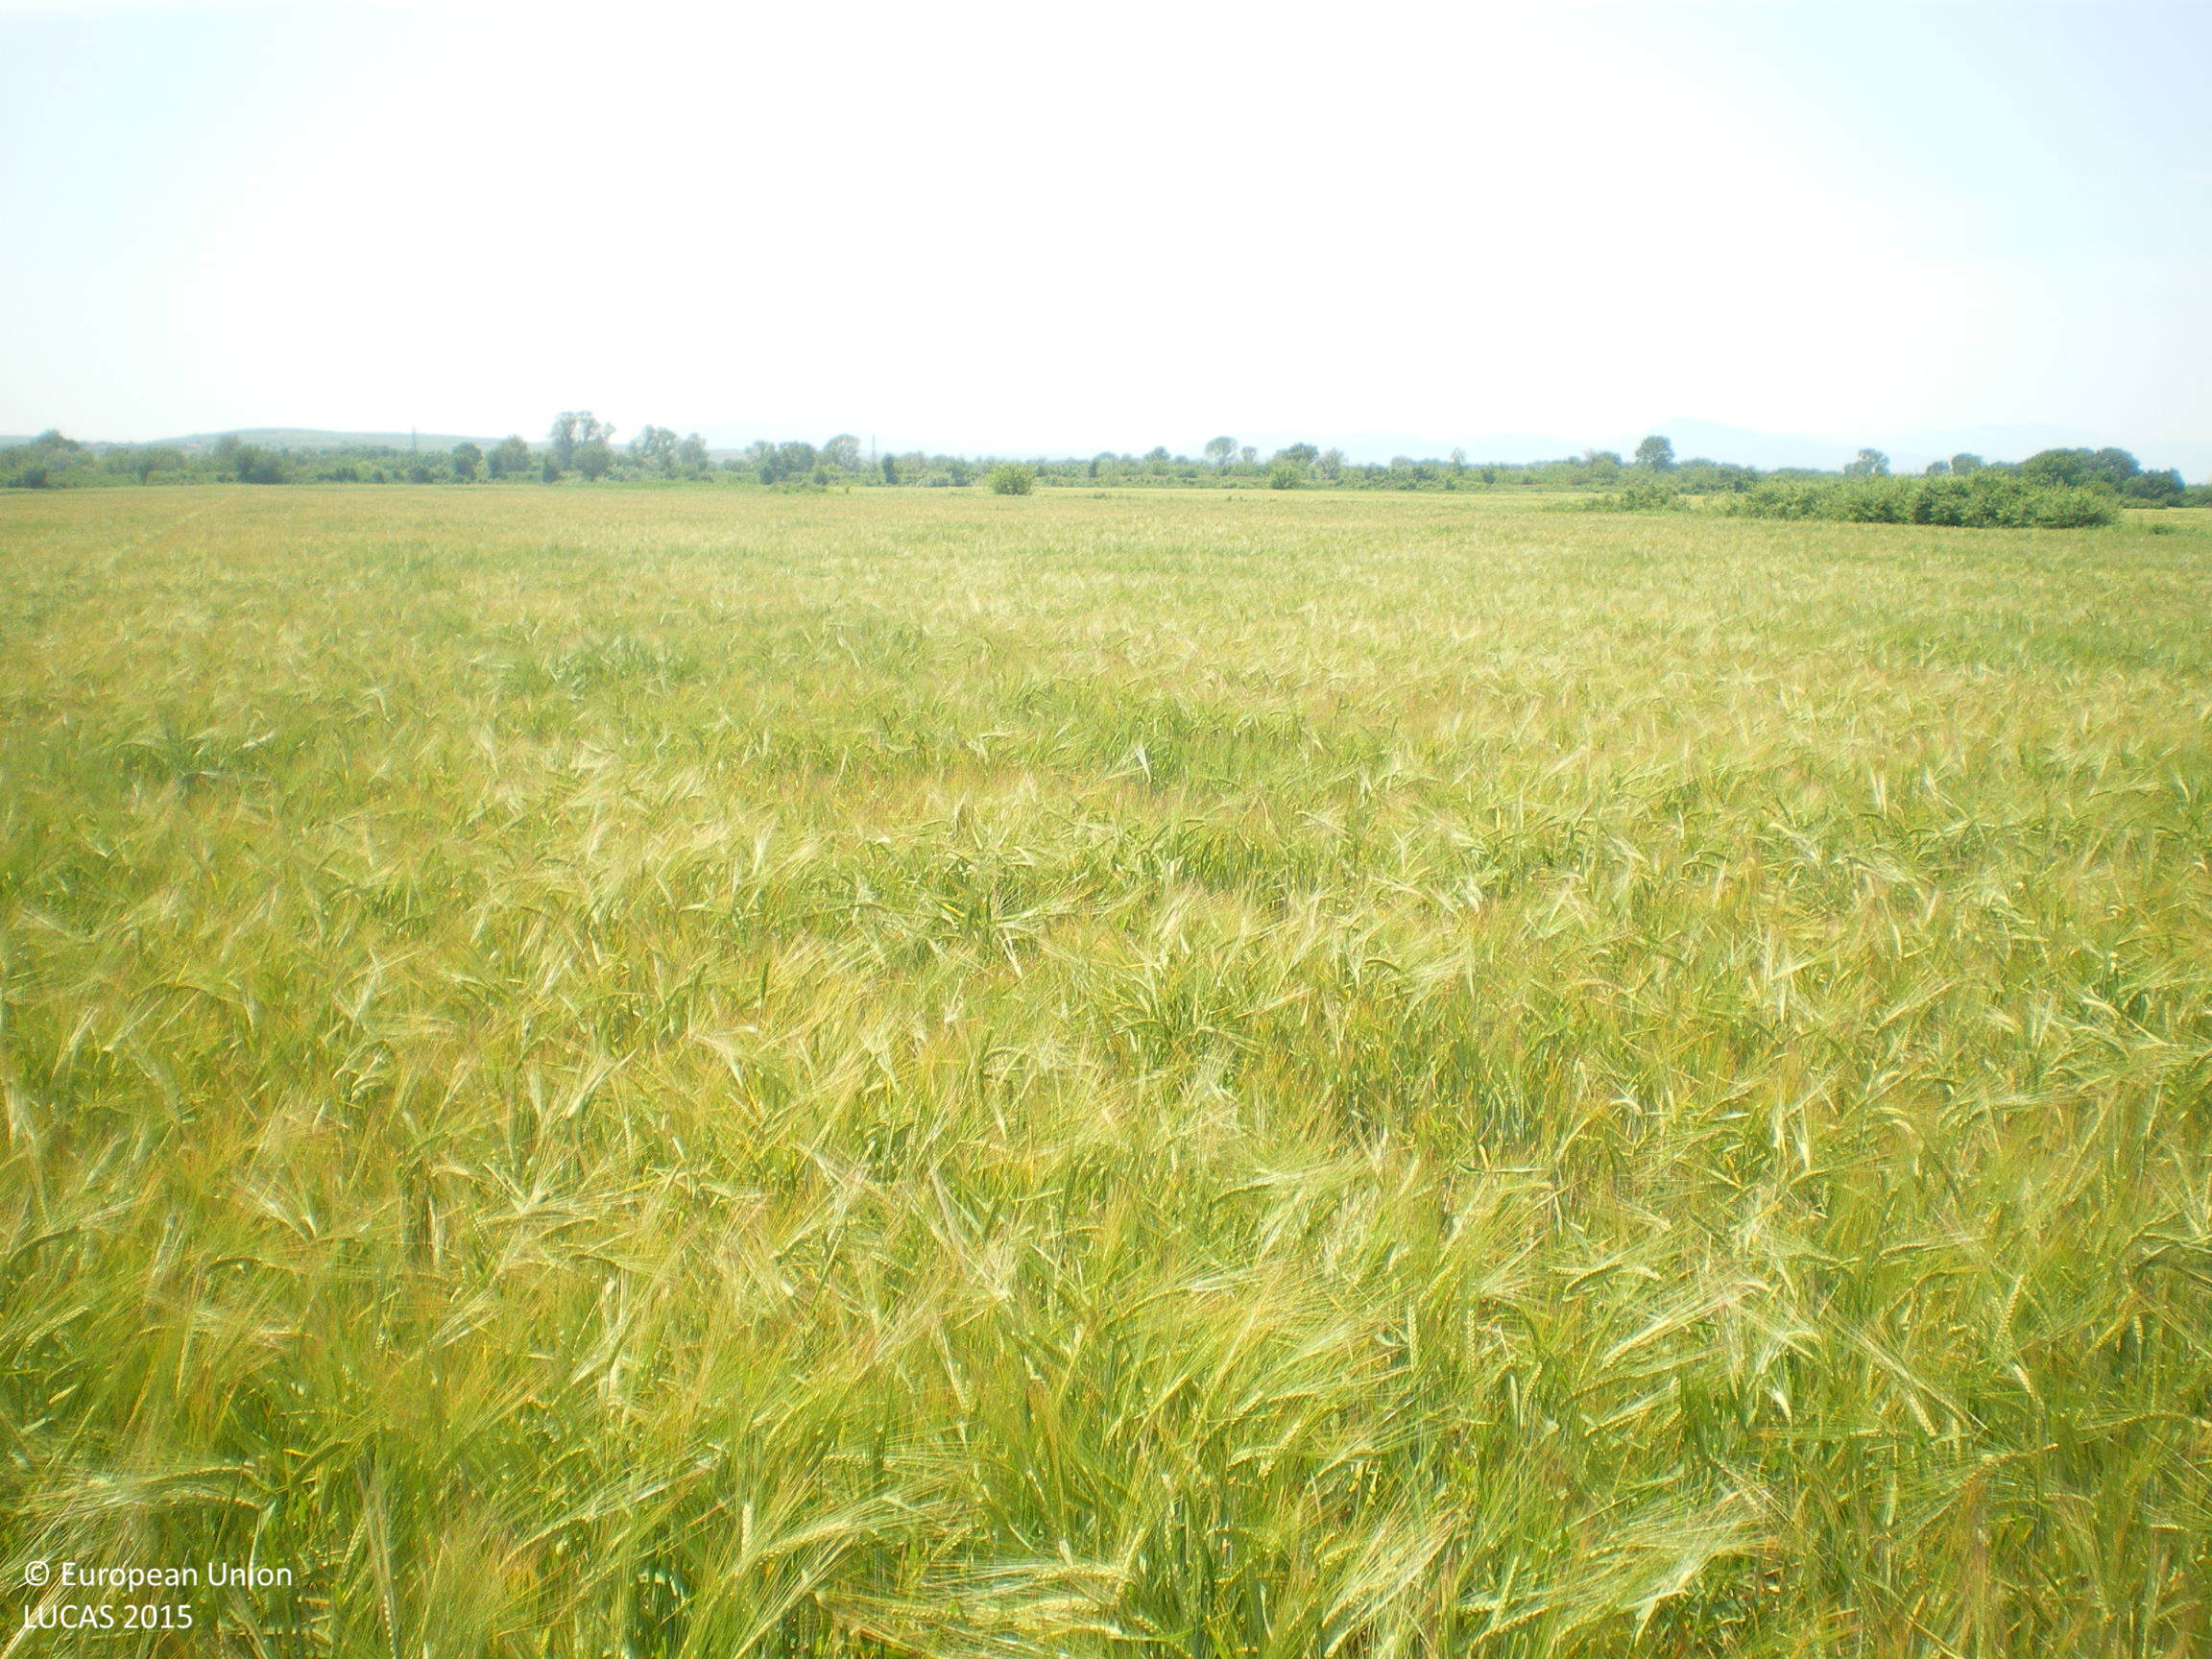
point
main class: Cropland
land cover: Barley
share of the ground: > 75 %
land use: Agriculture (excluding fallow land and kitchen gardens)
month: May
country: BG
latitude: 42.1125
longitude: 25.3864
